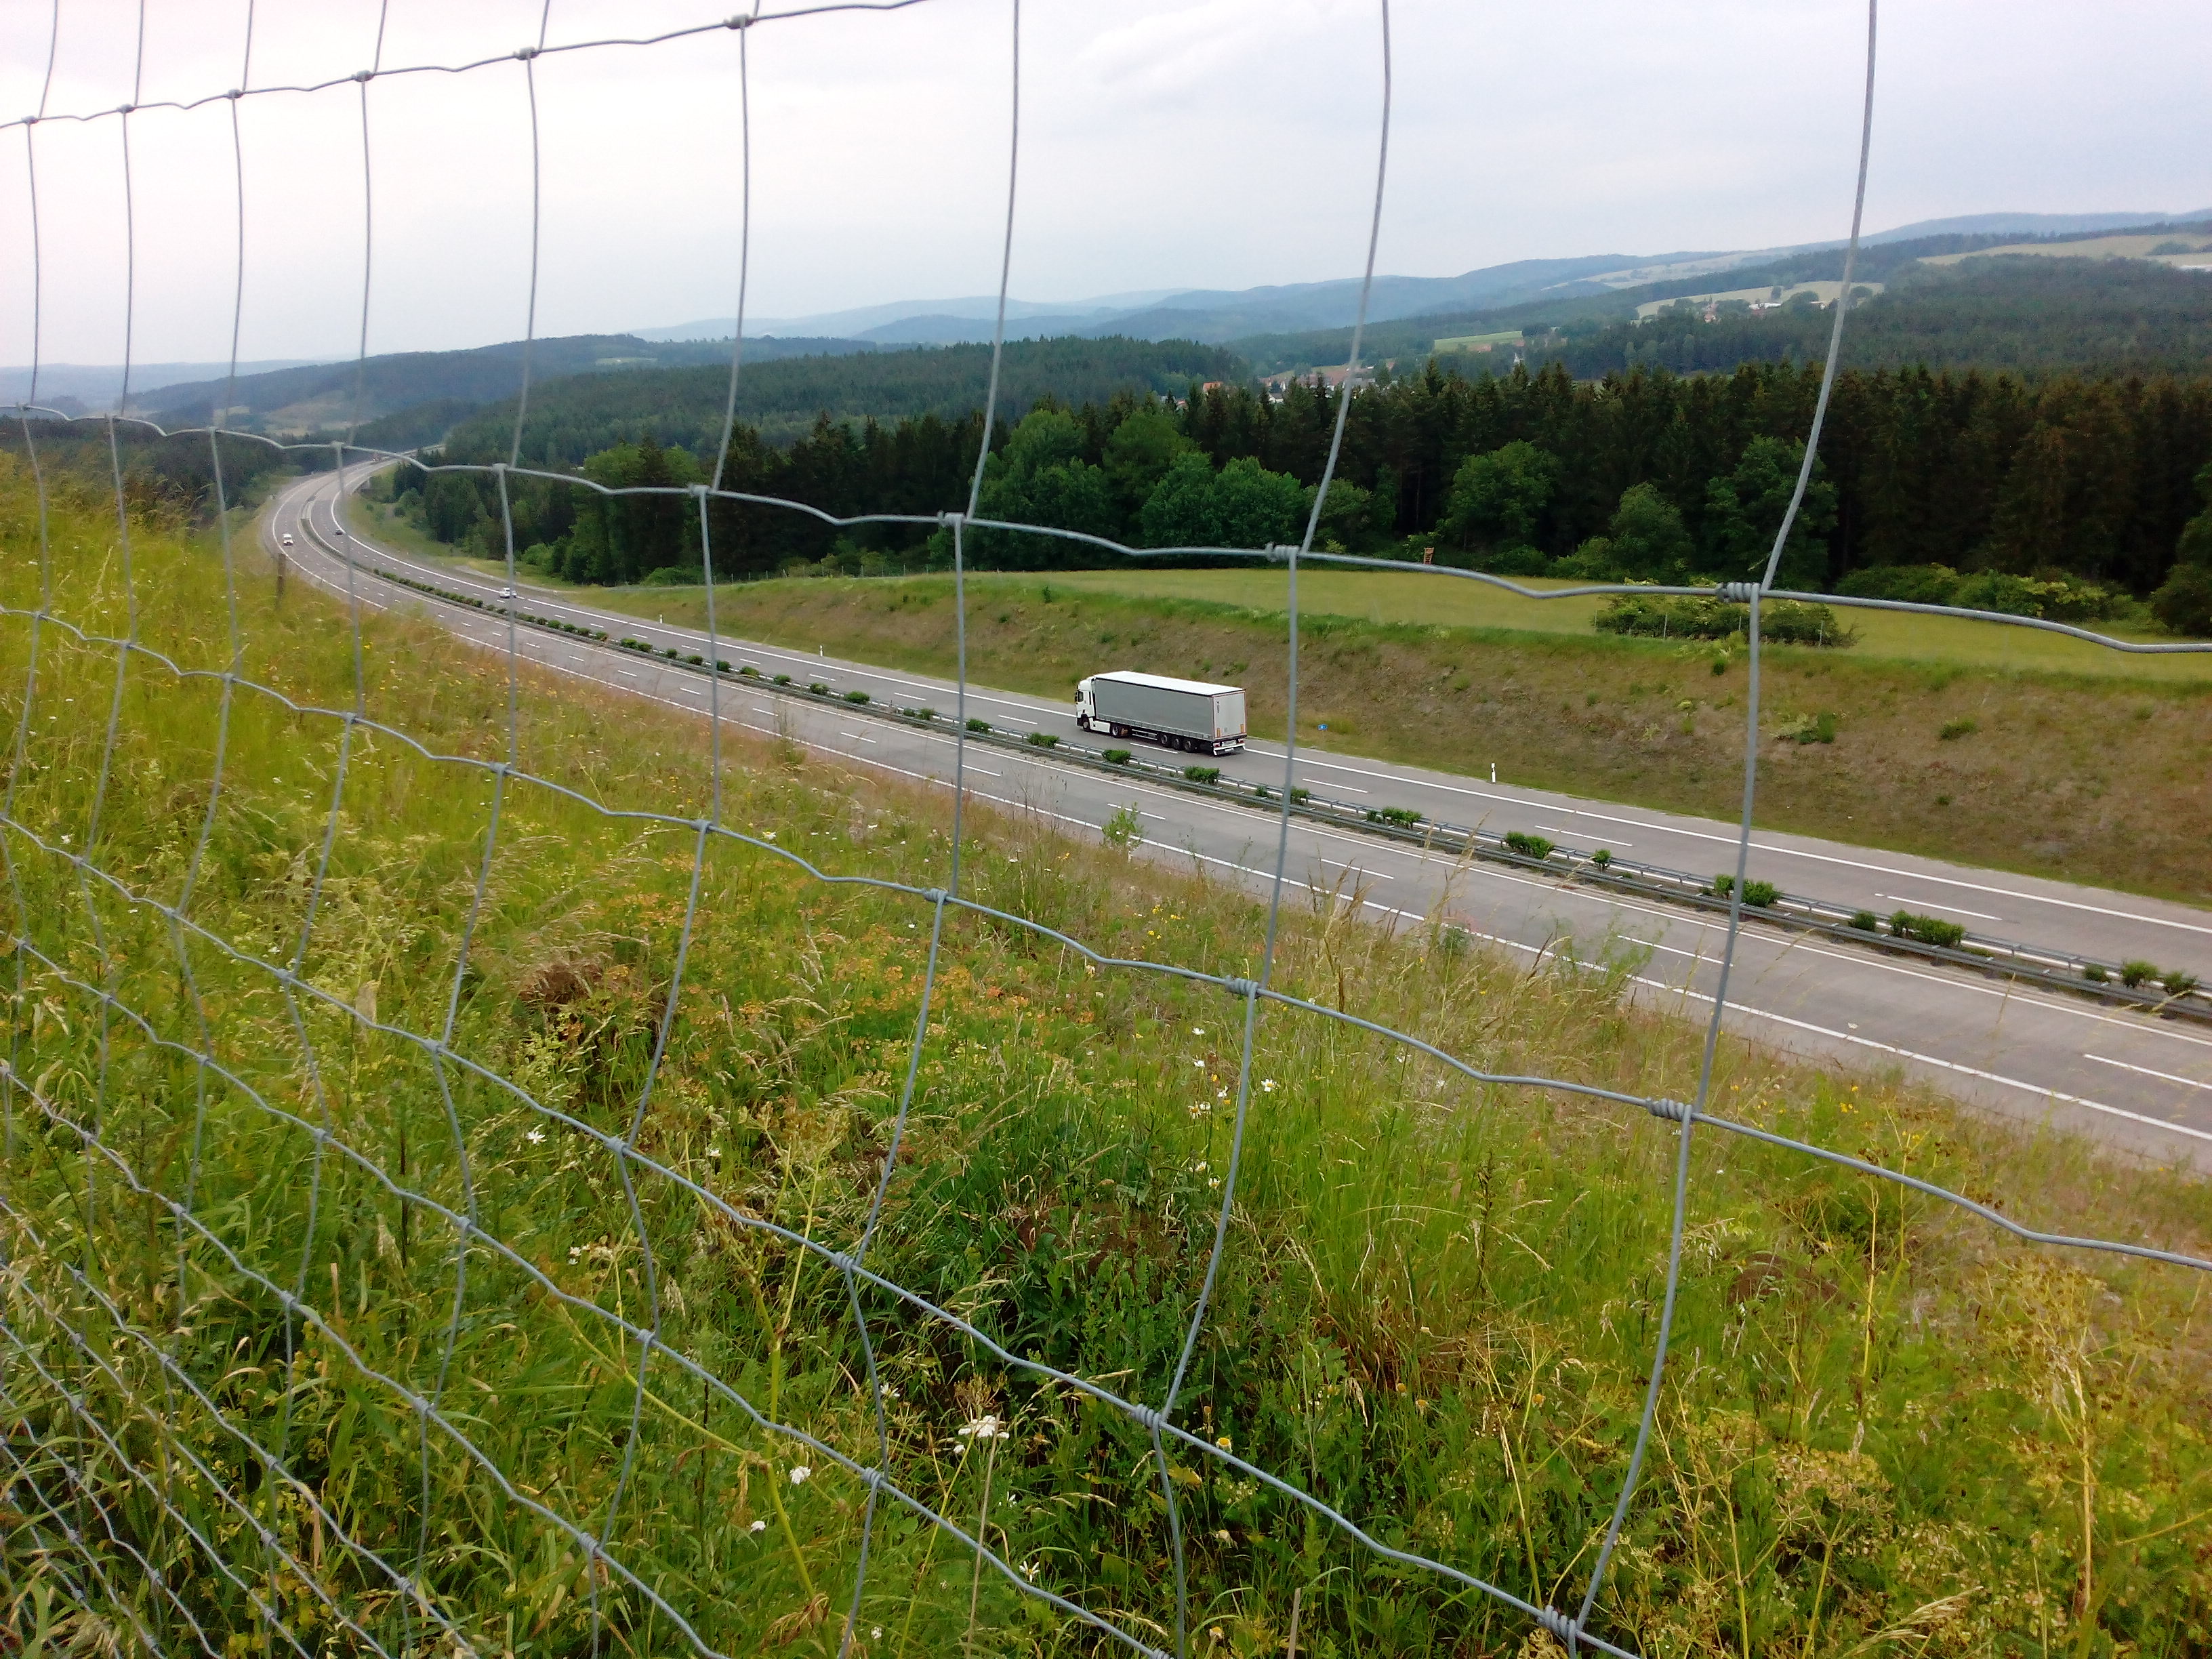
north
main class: Grassland
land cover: Grassland without tree/shrub cover
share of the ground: > 75 %
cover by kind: herbaceous plants 100 %
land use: Road transport
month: June
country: DE
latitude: 50.4689
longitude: 10.8310
